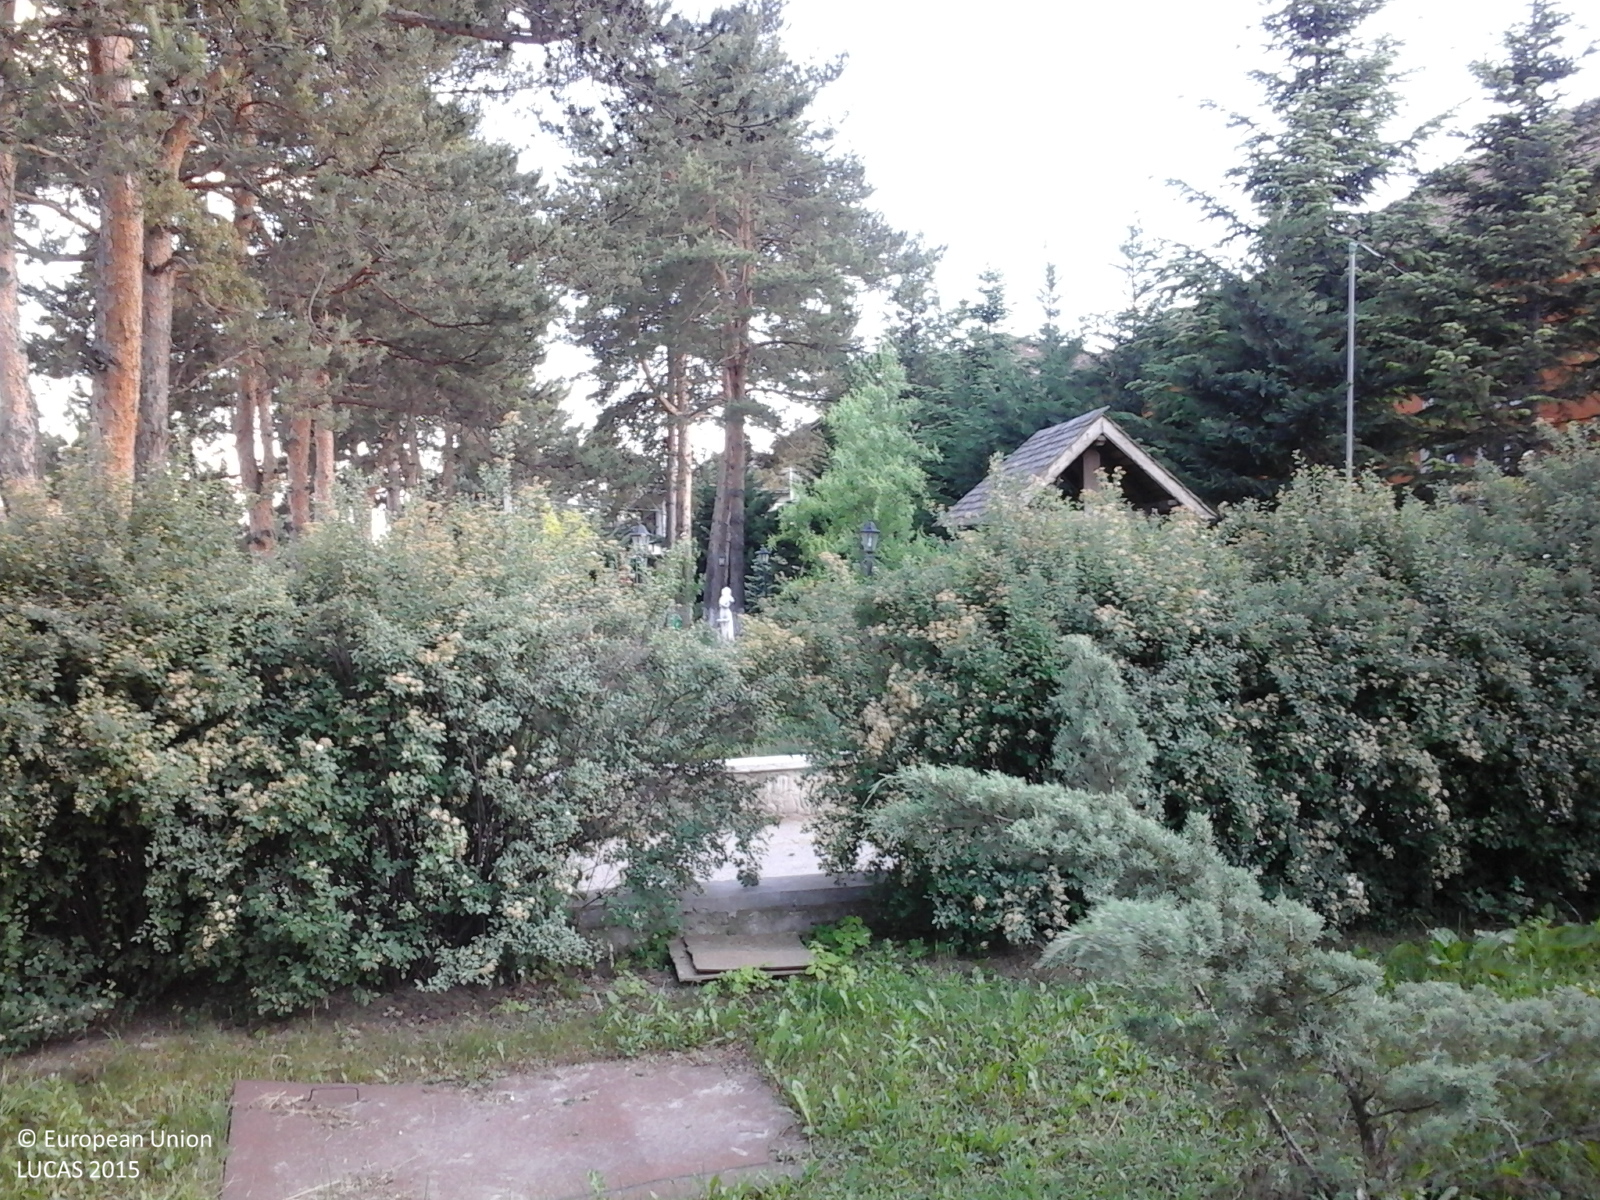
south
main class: Grassland
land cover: Grassland with sparse tree/shrub cover
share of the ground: > 75 %
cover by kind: herbaceous plants 95 %, broadleaved forest trees 5 %
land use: Amenities, museums, leisure
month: May
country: RO
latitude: 45.3194
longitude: 26.3598
